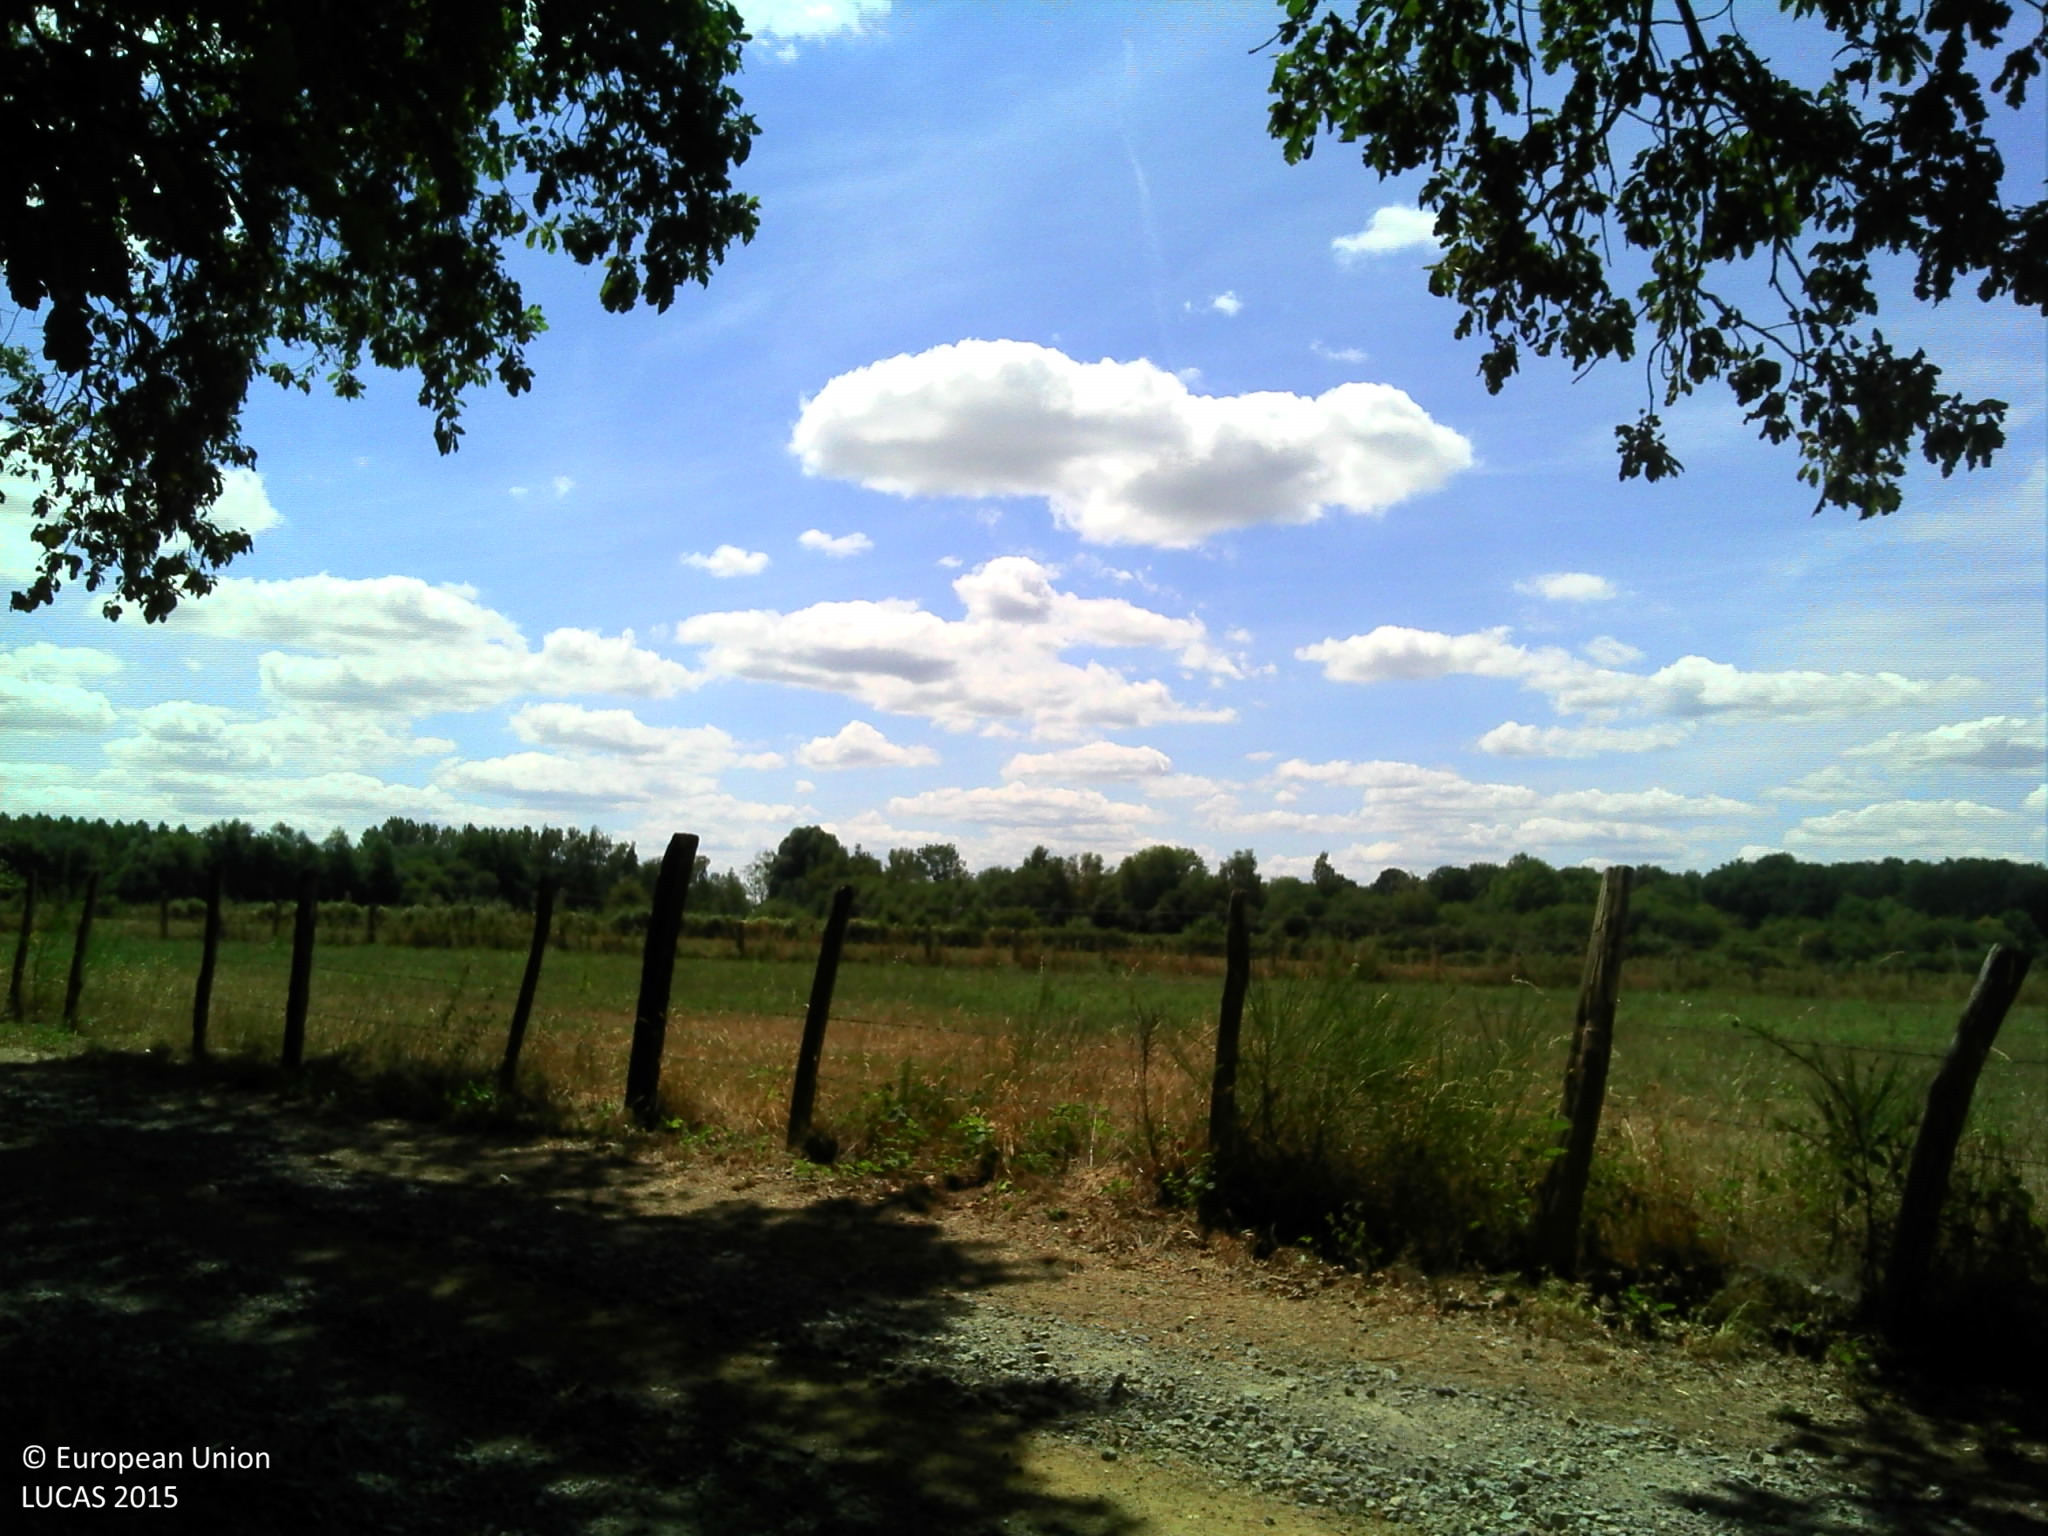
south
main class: Woodland
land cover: Broadleaved woodland
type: acidophilous oak and oak-birch forest
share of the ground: > 75 %
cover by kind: broadleaved forest trees 50 %, shrubs 30 %, herbaceous plants 20 %
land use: Forestry
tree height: > 5 m
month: July
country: FR
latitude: 48.0542
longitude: 0.5721
